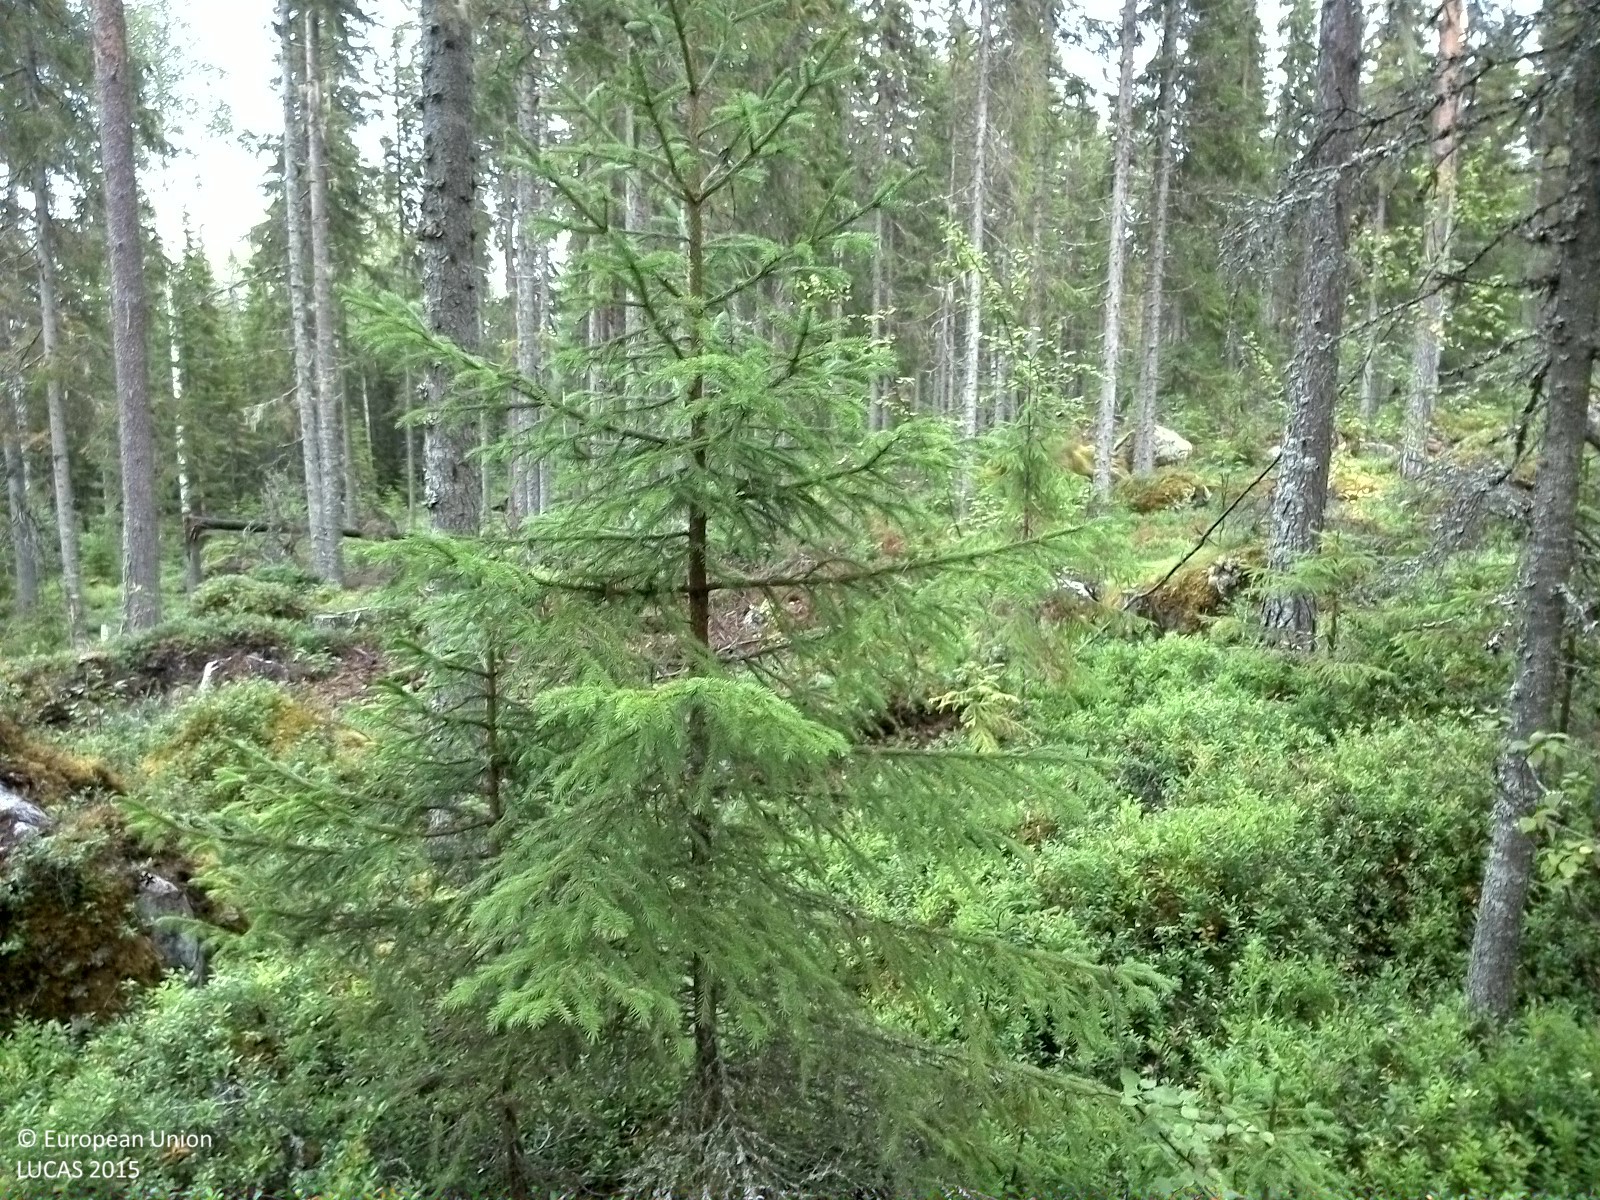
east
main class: Woodland
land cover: Spruce dominated coniferous woodland
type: boreal forest
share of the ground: 25 - 50 %
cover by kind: shrubs 70 %, coniferous forest trees 25 %, lichens and mosses 5 %
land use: Forestry
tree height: > 5 m
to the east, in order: Spruce dominated coniferous woodland; Tracks; Spruce dominated coniferous woodland; Tracks; Spruce dominated coniferous woodland; Spruce dominated mixed woodland; Other mixed woodland; Ditches and canals; Paved roads, cycling and walking lanes; Ditches and canals; Other mixed woodland
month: August
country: SE
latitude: 62.6670
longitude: 16.1668
